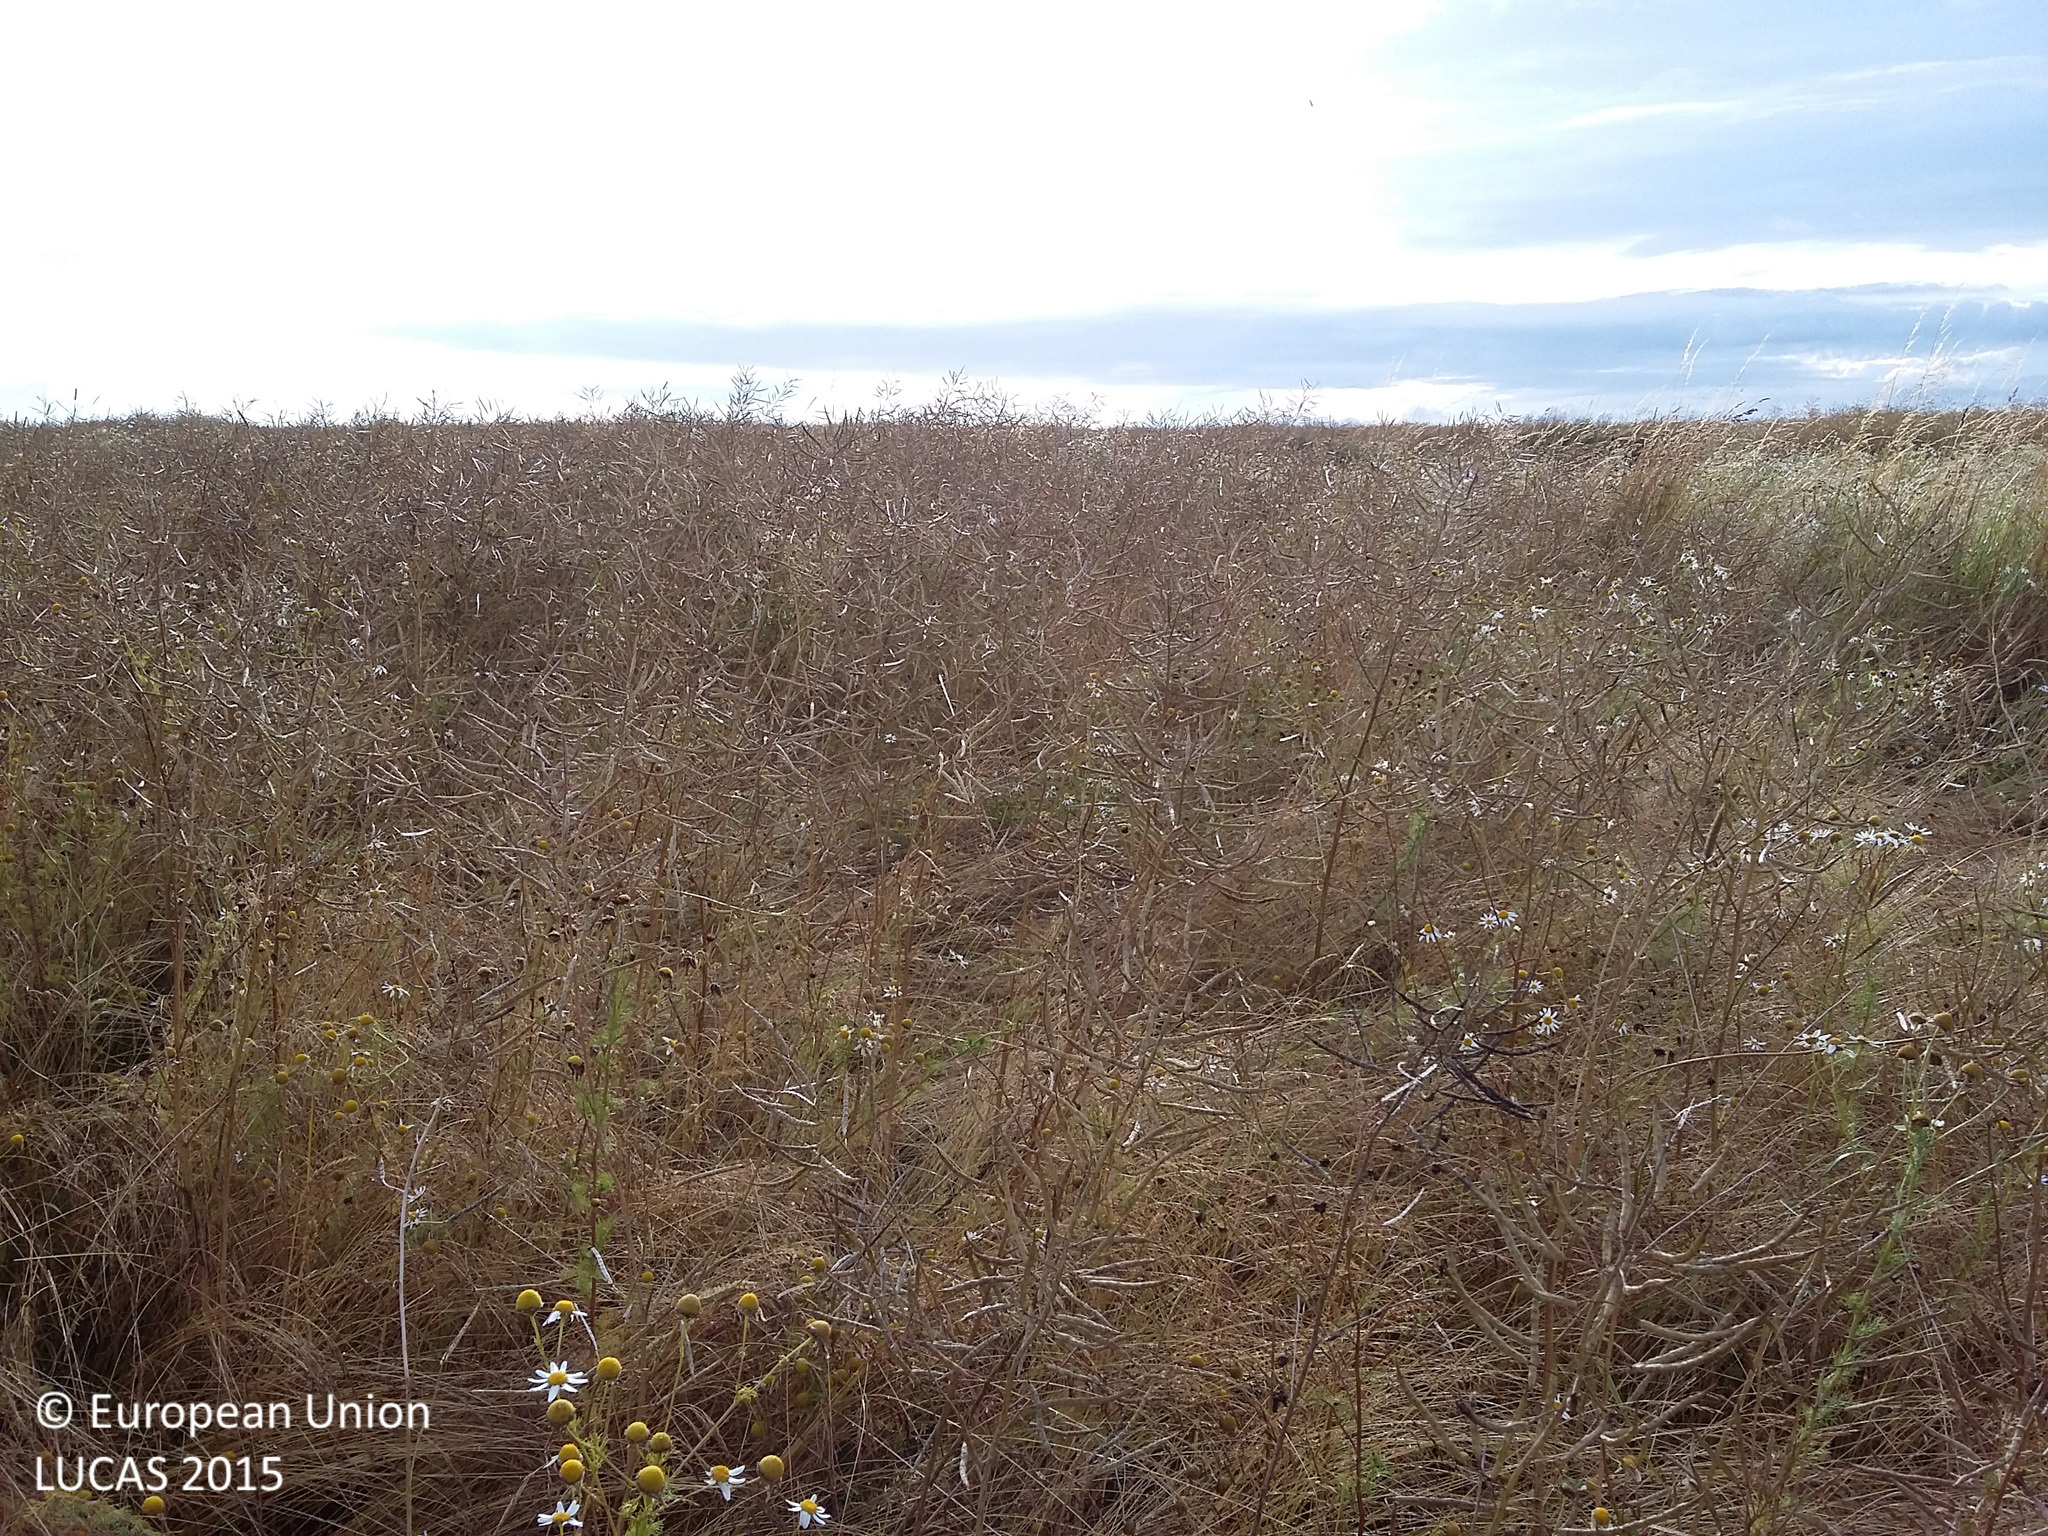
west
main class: Cropland
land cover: Rape and turnip rape
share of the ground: > 75 %
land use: Agriculture (excluding fallow land and kitchen gardens)
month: July
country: DK
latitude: 55.8640
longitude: 12.1551
